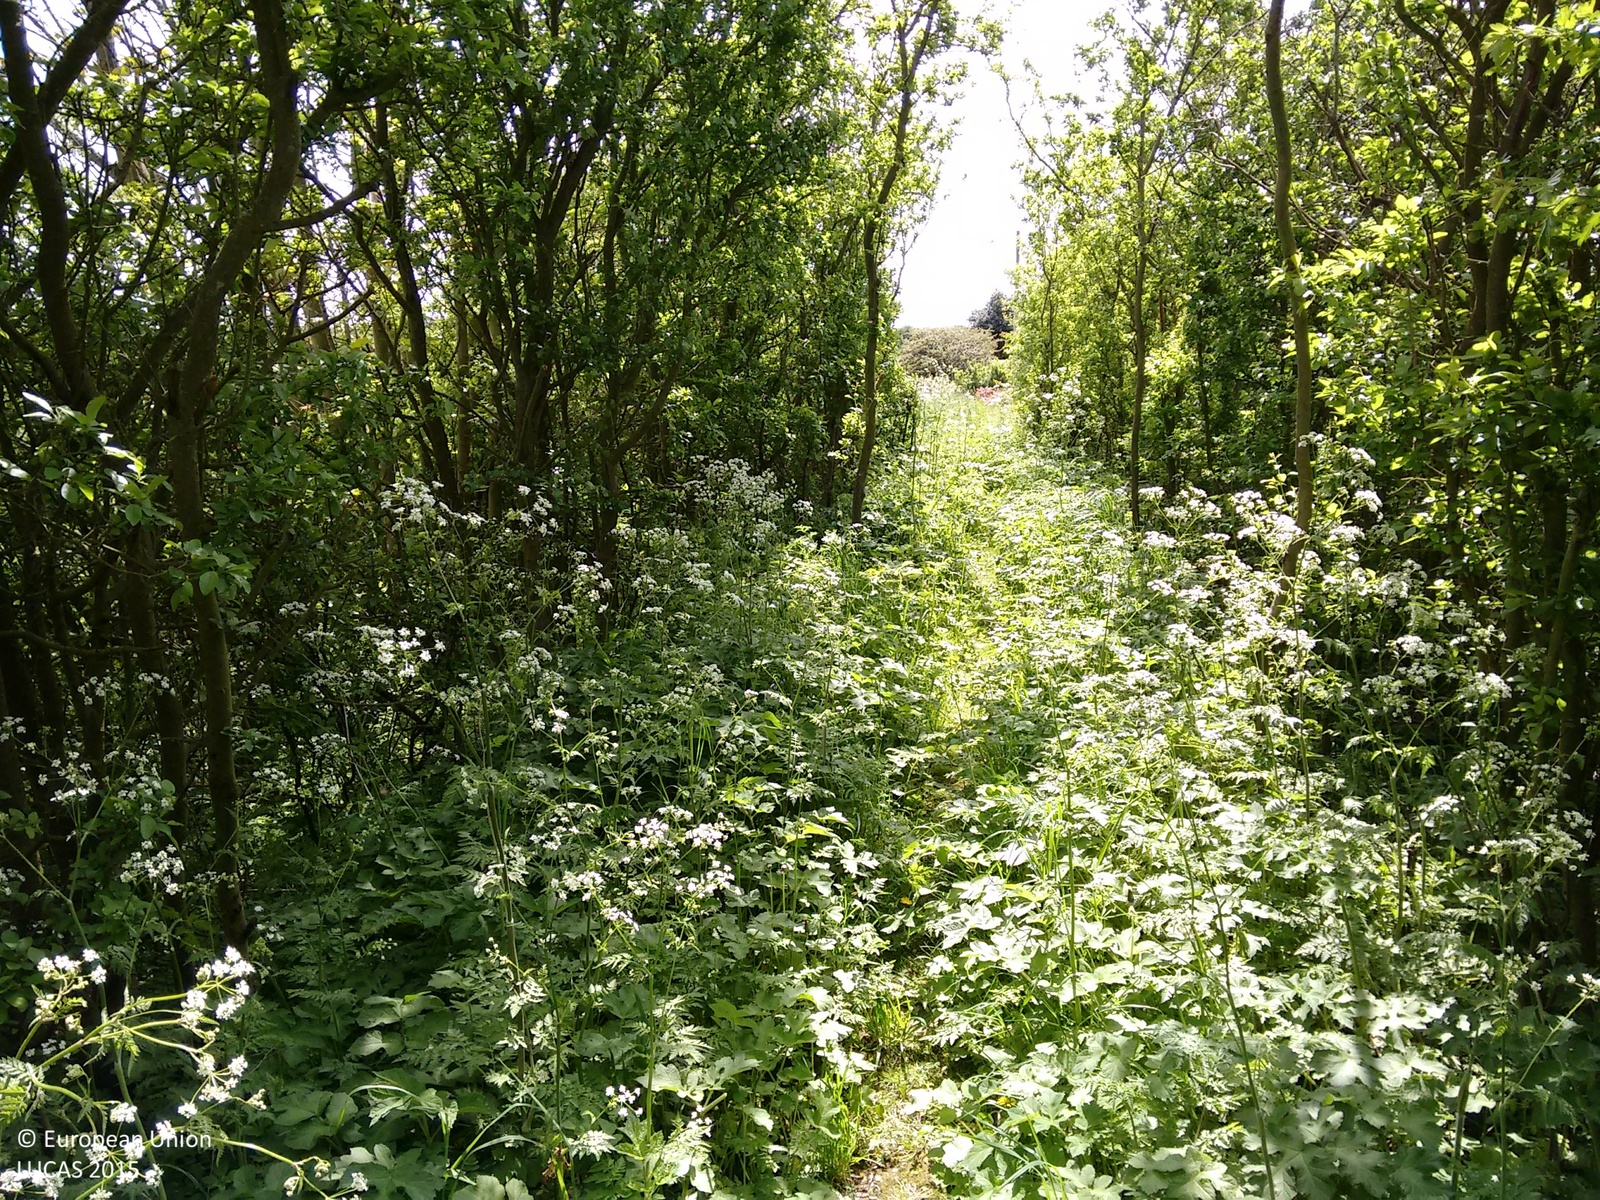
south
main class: Woodland
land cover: Broadleaved woodland
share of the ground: 10 - 25 %
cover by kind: herbaceous plants 80 %, broadleaved forest trees 20 %
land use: Semi-natural and natural areas not in use
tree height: < 5 m
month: May
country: GB
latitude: 52.9339
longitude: 0.0146
